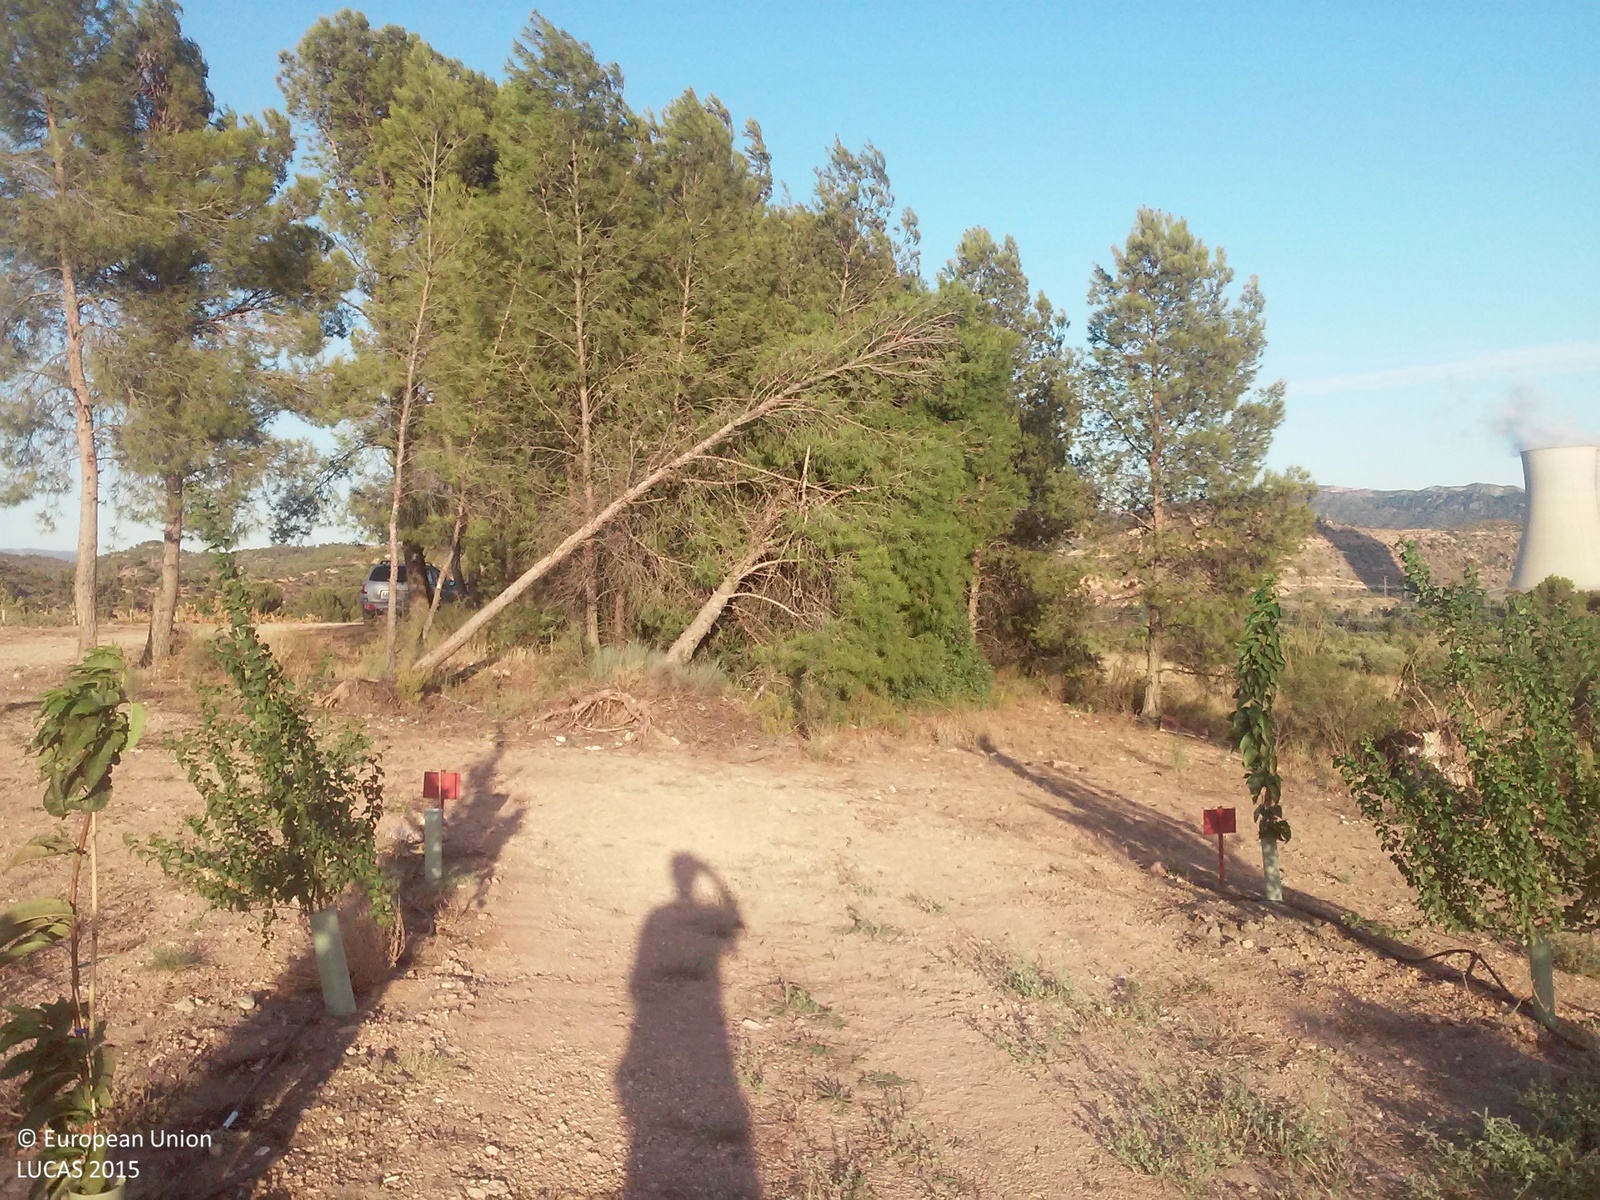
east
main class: Cropland
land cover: Other fruit trees and berries
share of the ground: < 10 %
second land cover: Spontaneously vegetated surfaces
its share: > 75 %
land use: Agriculture (excluding fallow land and kitchen gardens)
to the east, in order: Other fruit trees and berries; Spontaneously vegetated surfaces; Pine dominated coniferous woodland; Grassland without tree/shrub cover; Shrubland with sparse tree cover; Pine dominated coniferous woodland; Grassland with sparse tree/shrub cover; Tracks; Grassland with sparse tree/shrub cover
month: August
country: ES
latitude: 41.2121
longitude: 0.5565
